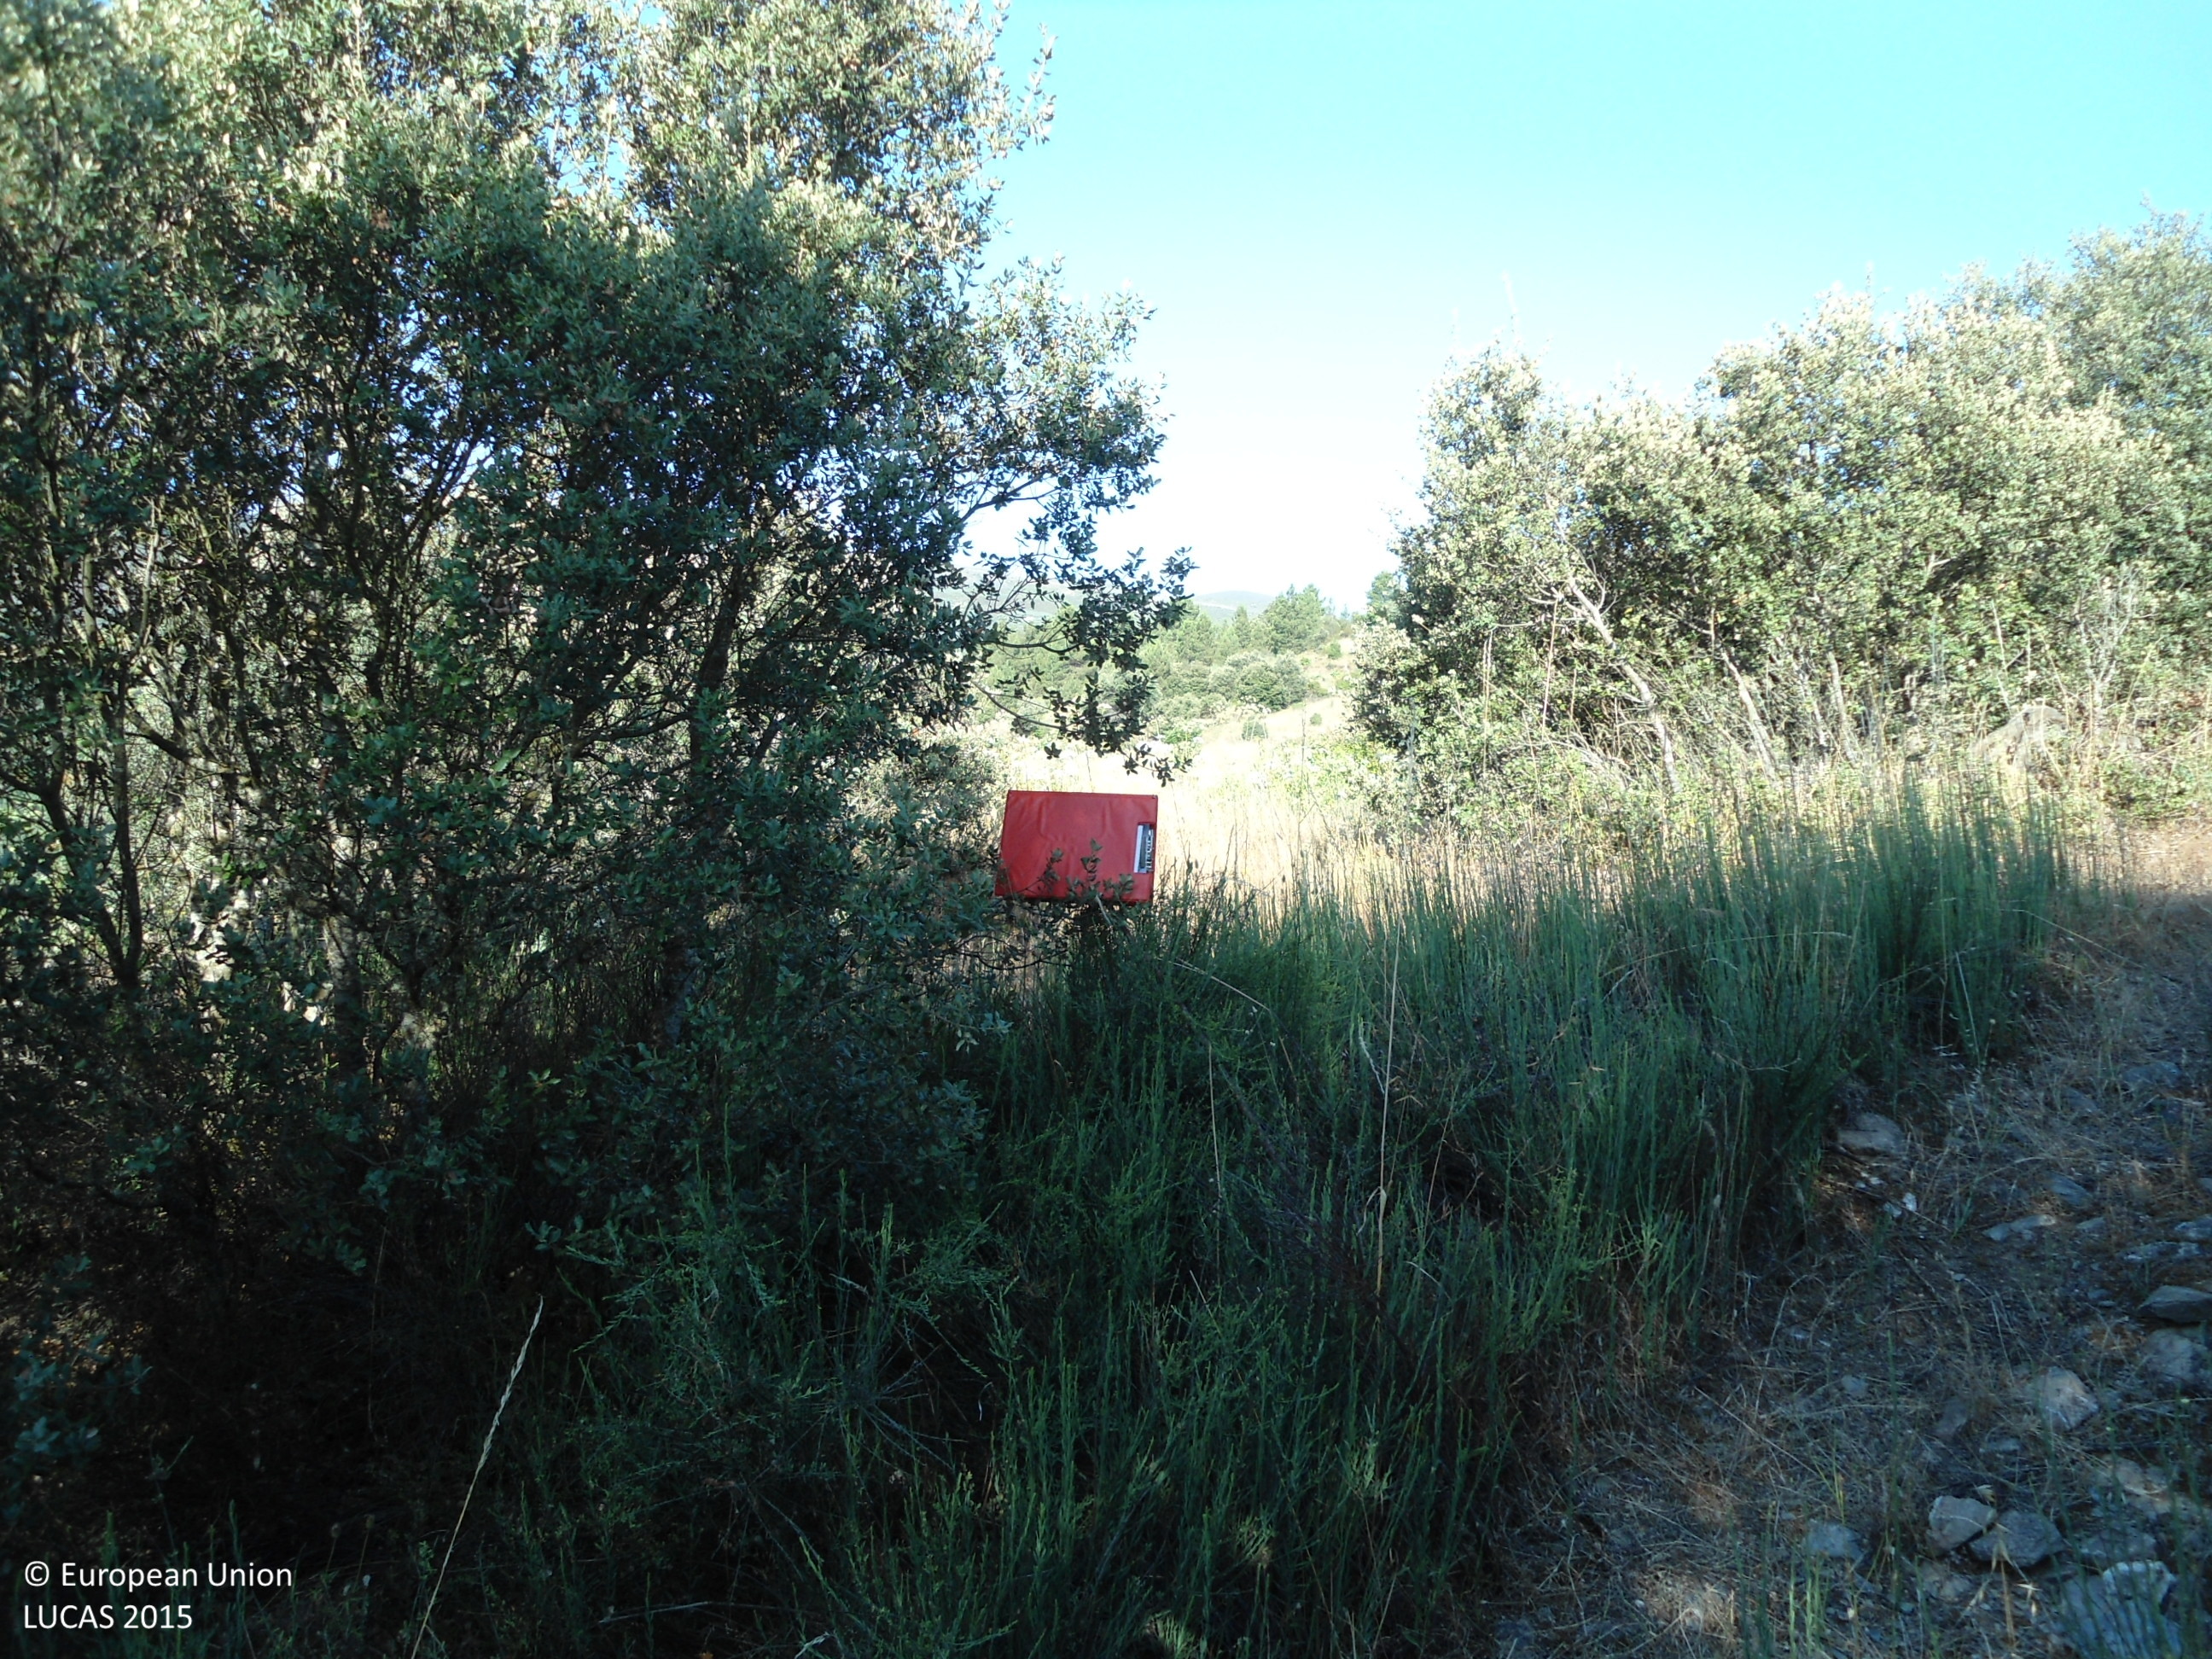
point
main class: Shrubland
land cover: Shrubland with sparse tree cover
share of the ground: > 75 %
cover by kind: shrubs 95 %, broadleaved forest trees 5 %
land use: Semi-natural and natural areas not in use
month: June
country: ES
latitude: 42.3860
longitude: -6.8742
